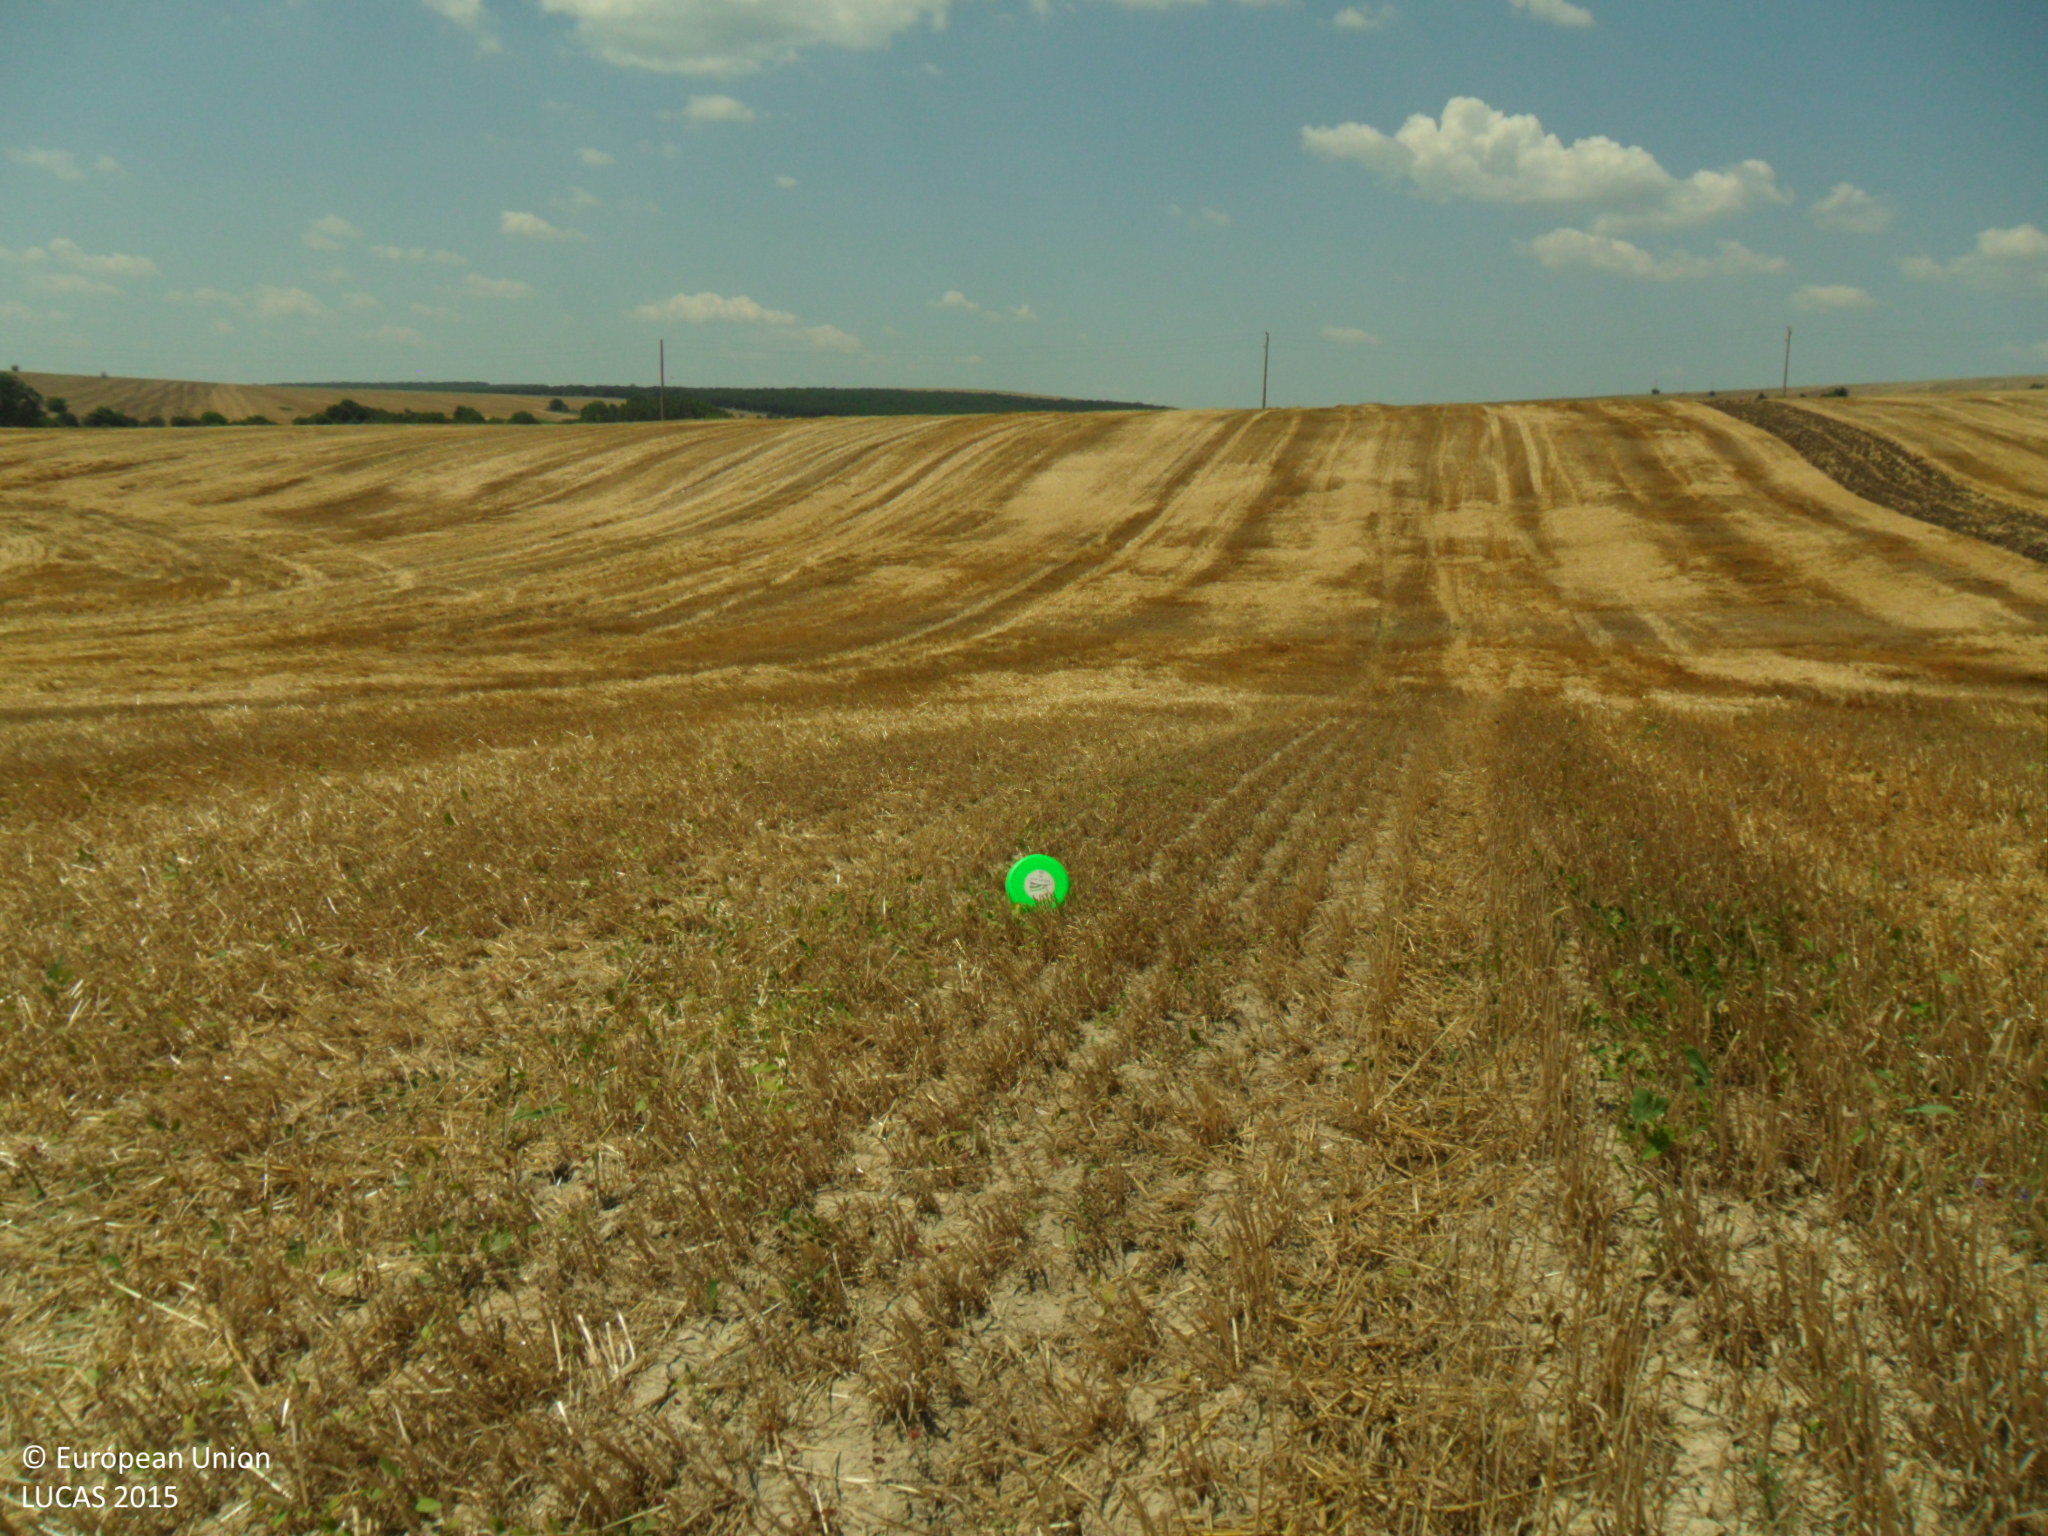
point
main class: Cropland
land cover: Common wheat
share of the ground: 10 - 25 %
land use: Agriculture (excluding fallow land and kitchen gardens)
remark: Harvested field
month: July
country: BG
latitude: 43.4216
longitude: 26.6207
